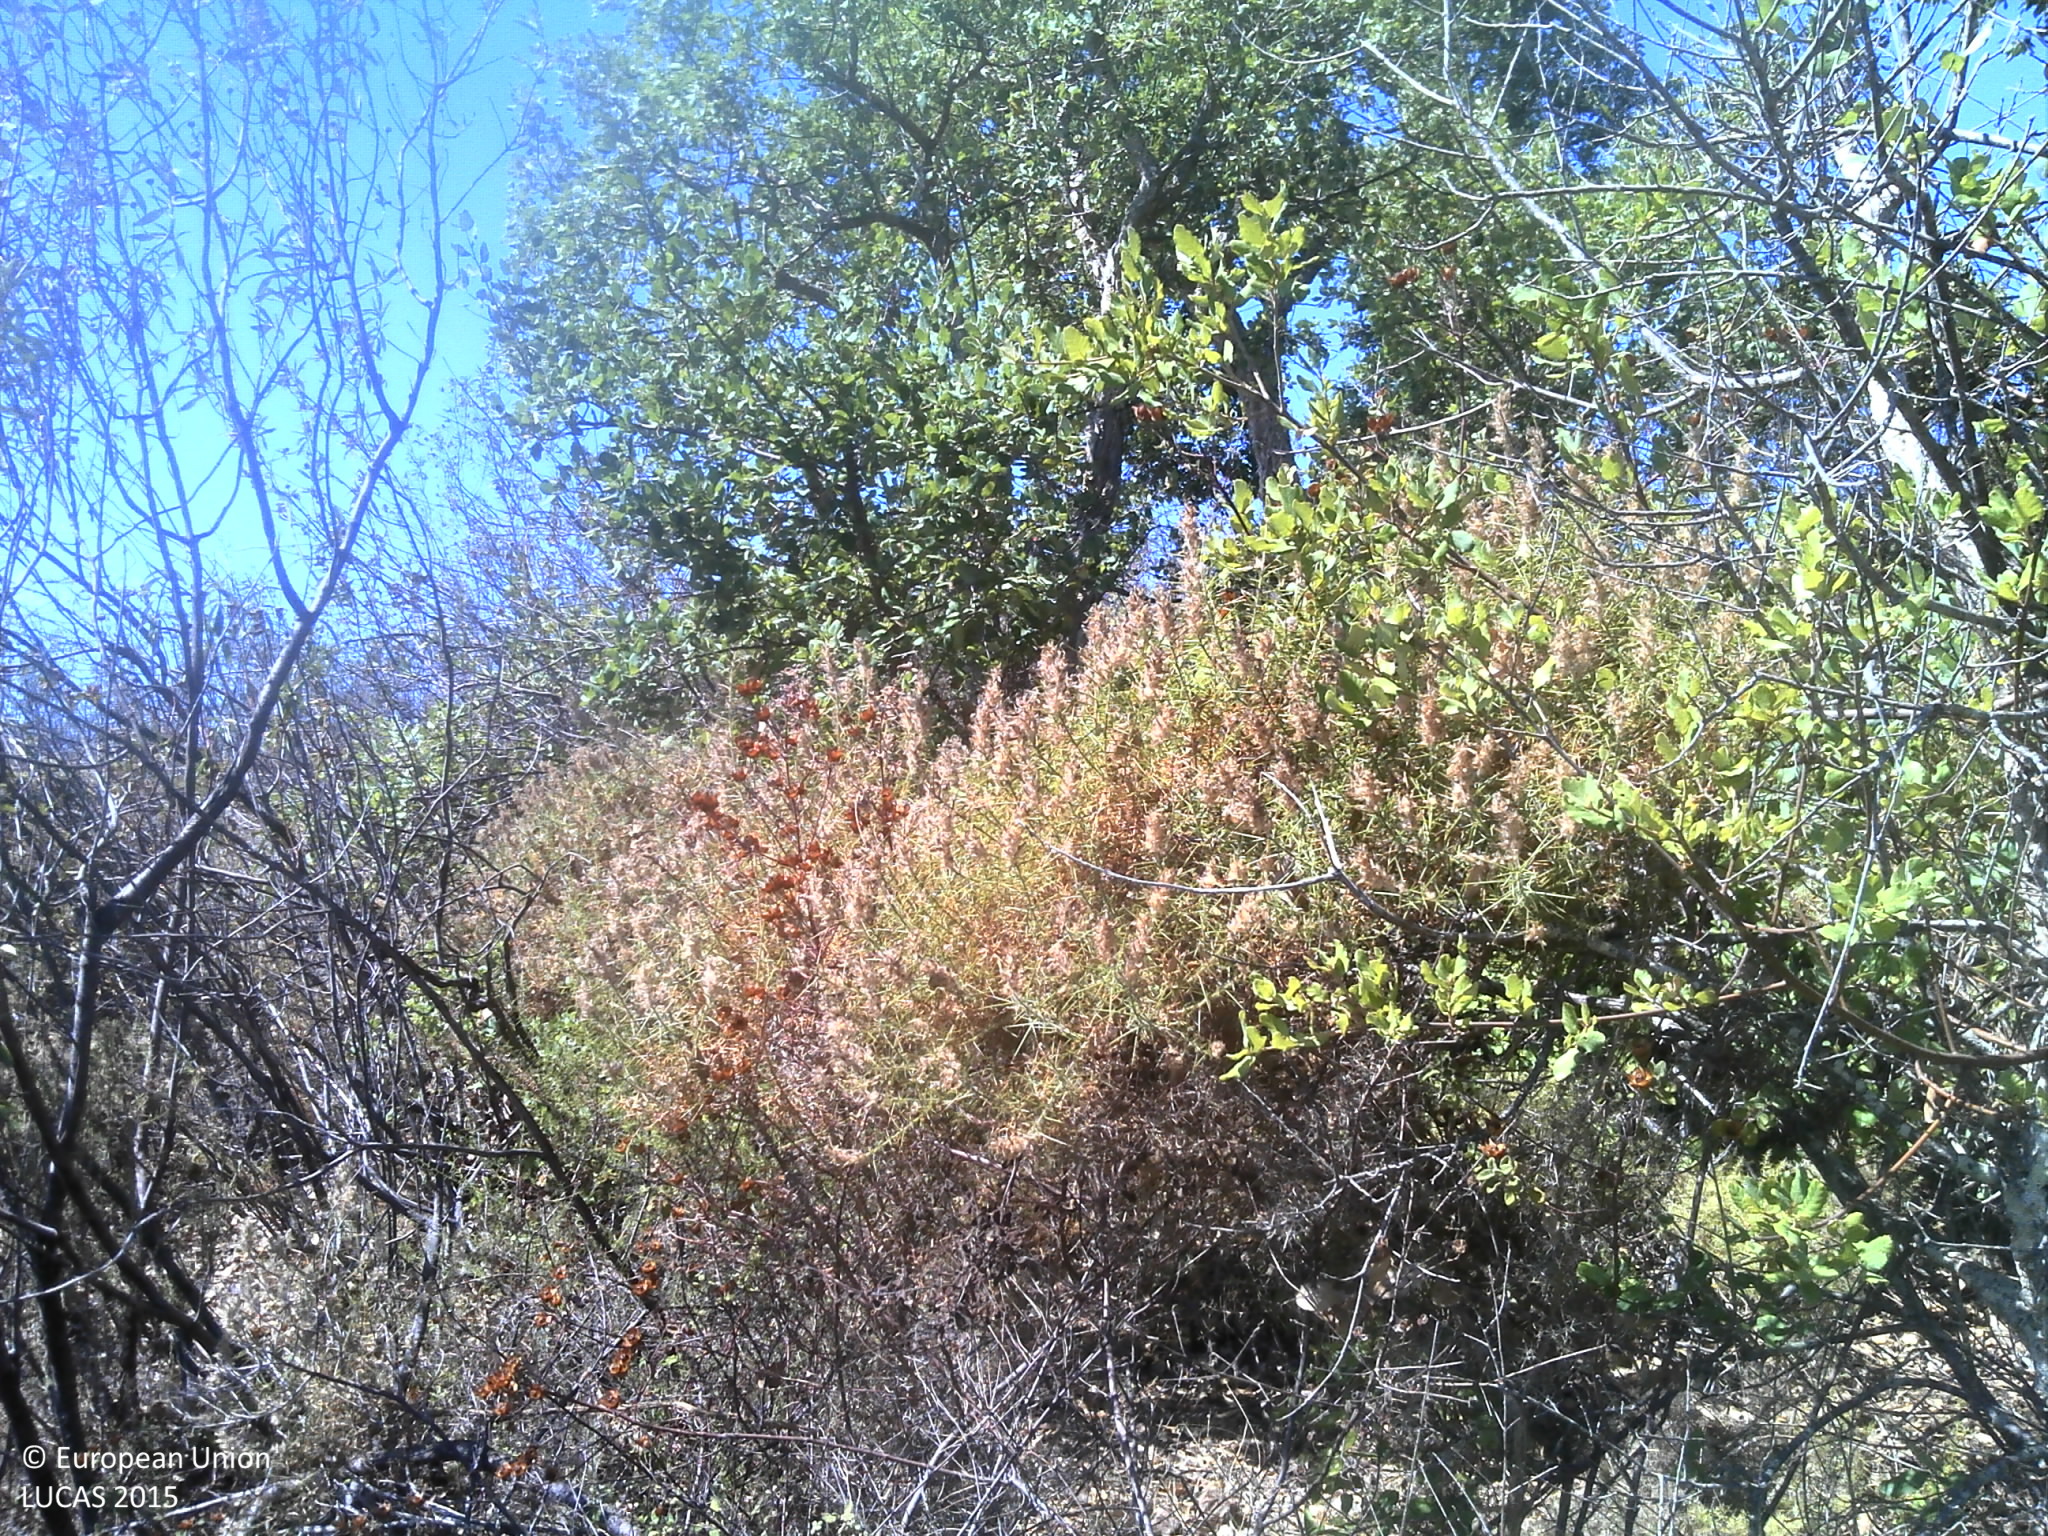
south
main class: Woodland
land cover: Broadleaved woodland
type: broadleaved evergreen forest
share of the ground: 25 - 50 %
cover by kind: shrubs 35 %, unconsolidated bare surface 35 %, broadleaved forest trees 30 %
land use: Forestry
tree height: > 5 m
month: August
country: PT
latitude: 37.1611
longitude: -8.7582
